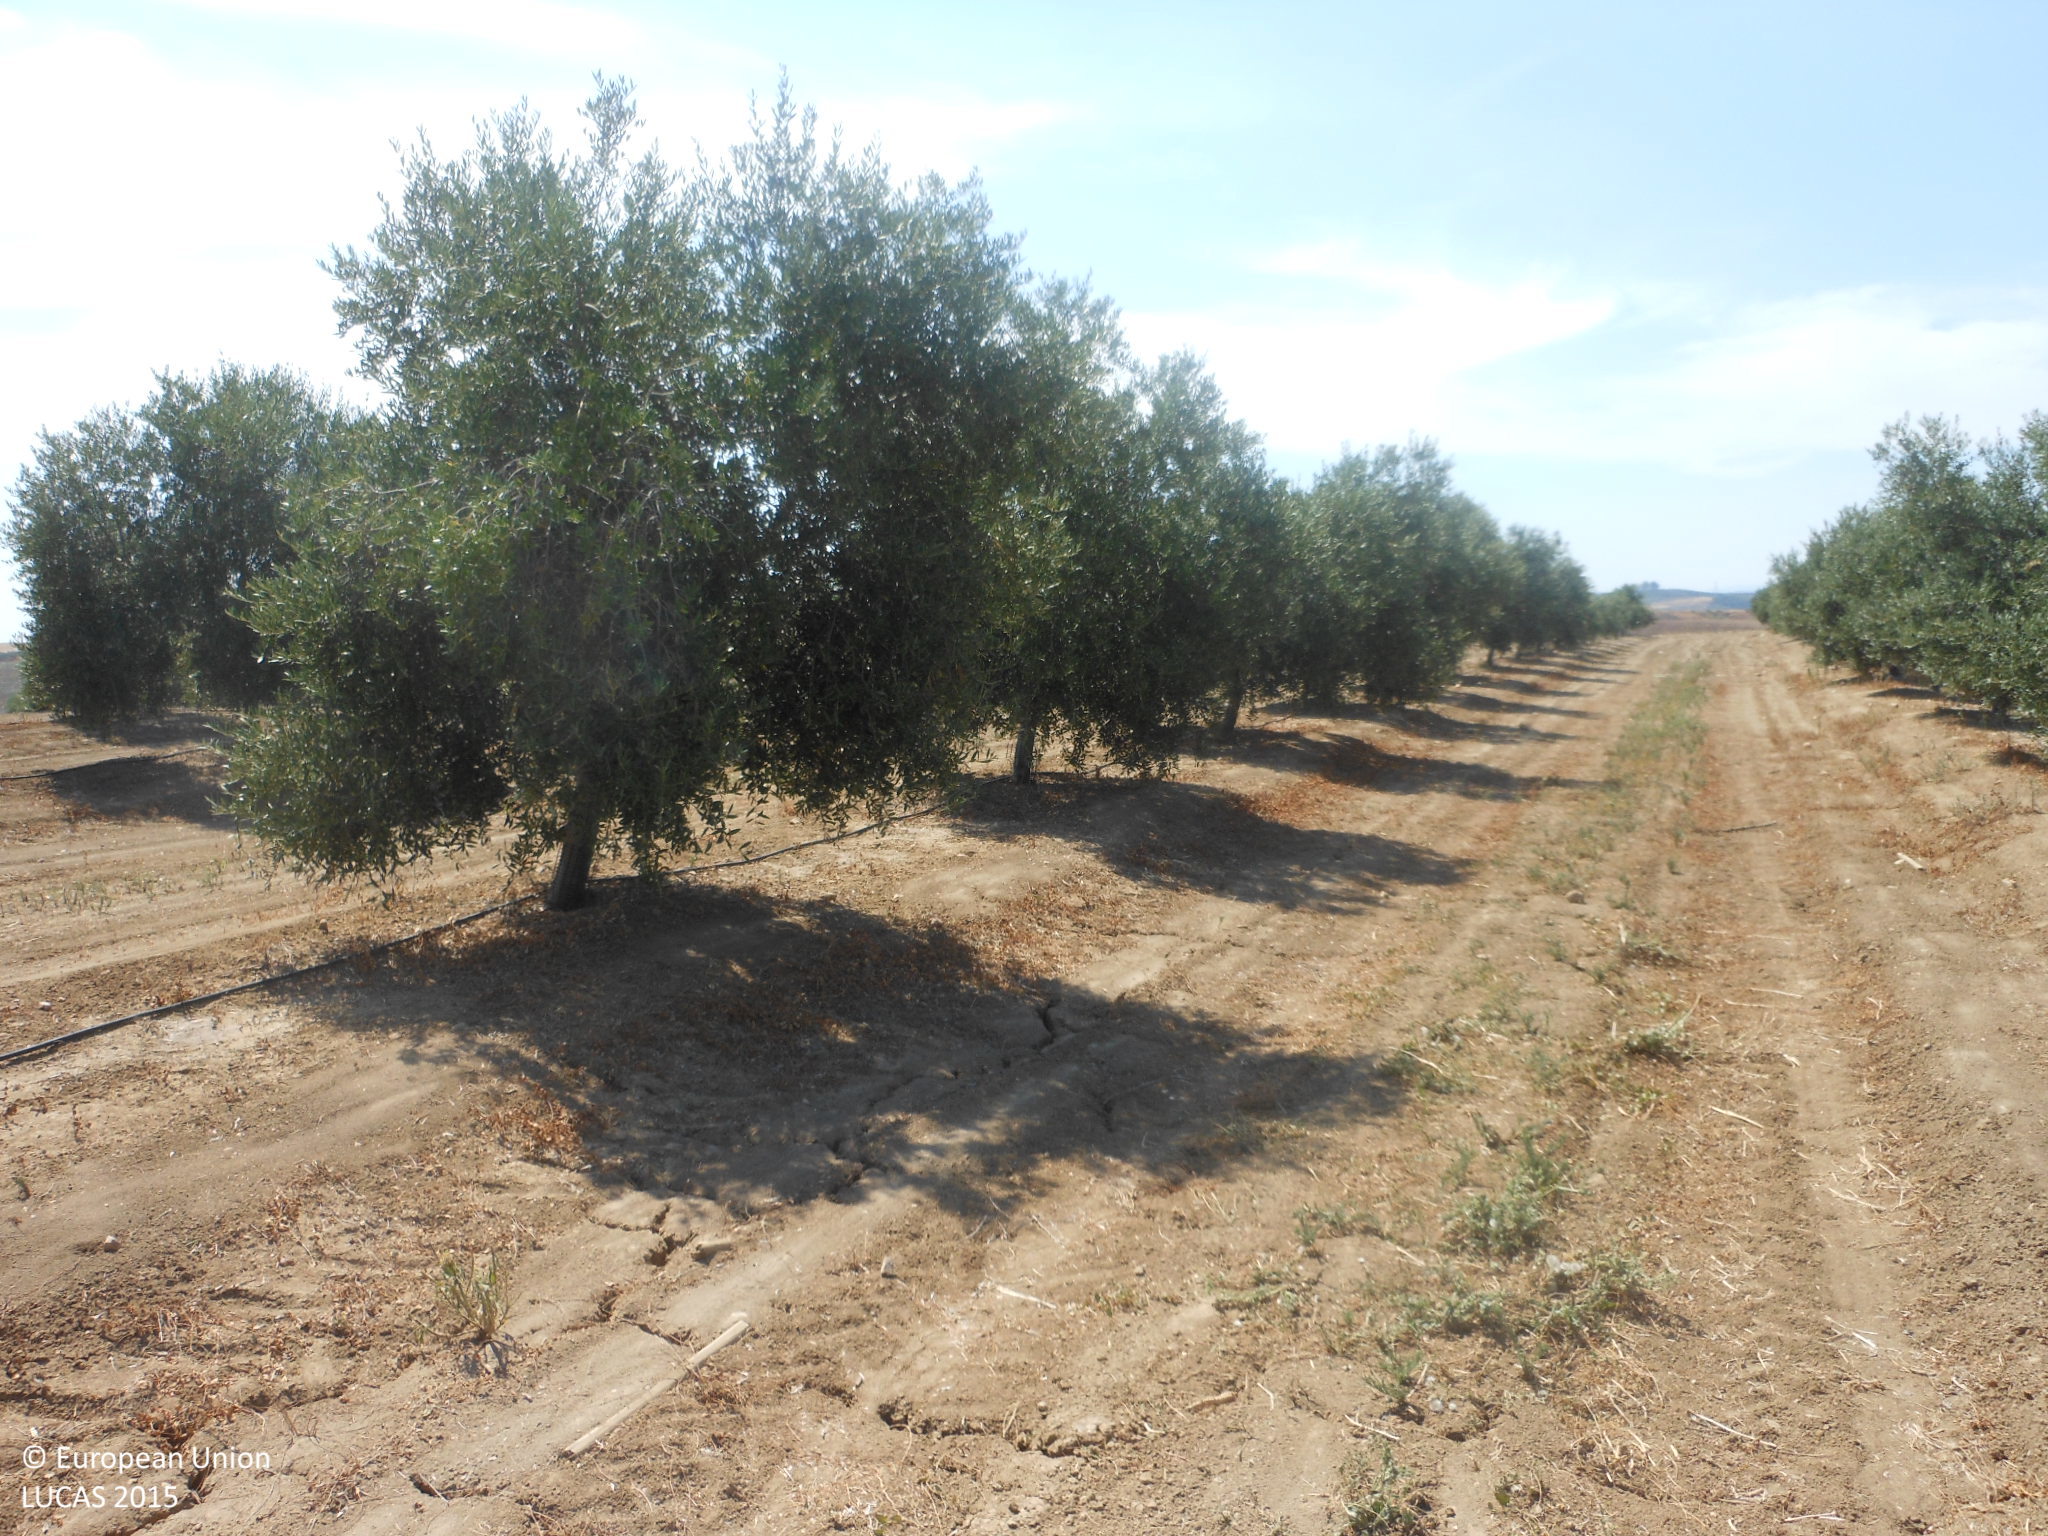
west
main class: Cropland
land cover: Olive groves
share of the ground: 50 - 75 %
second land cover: Other bare soil
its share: > 75 %
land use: Agriculture (excluding fallow land and kitchen gardens)
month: June
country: ES
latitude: 37.6424
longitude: -5.1910
